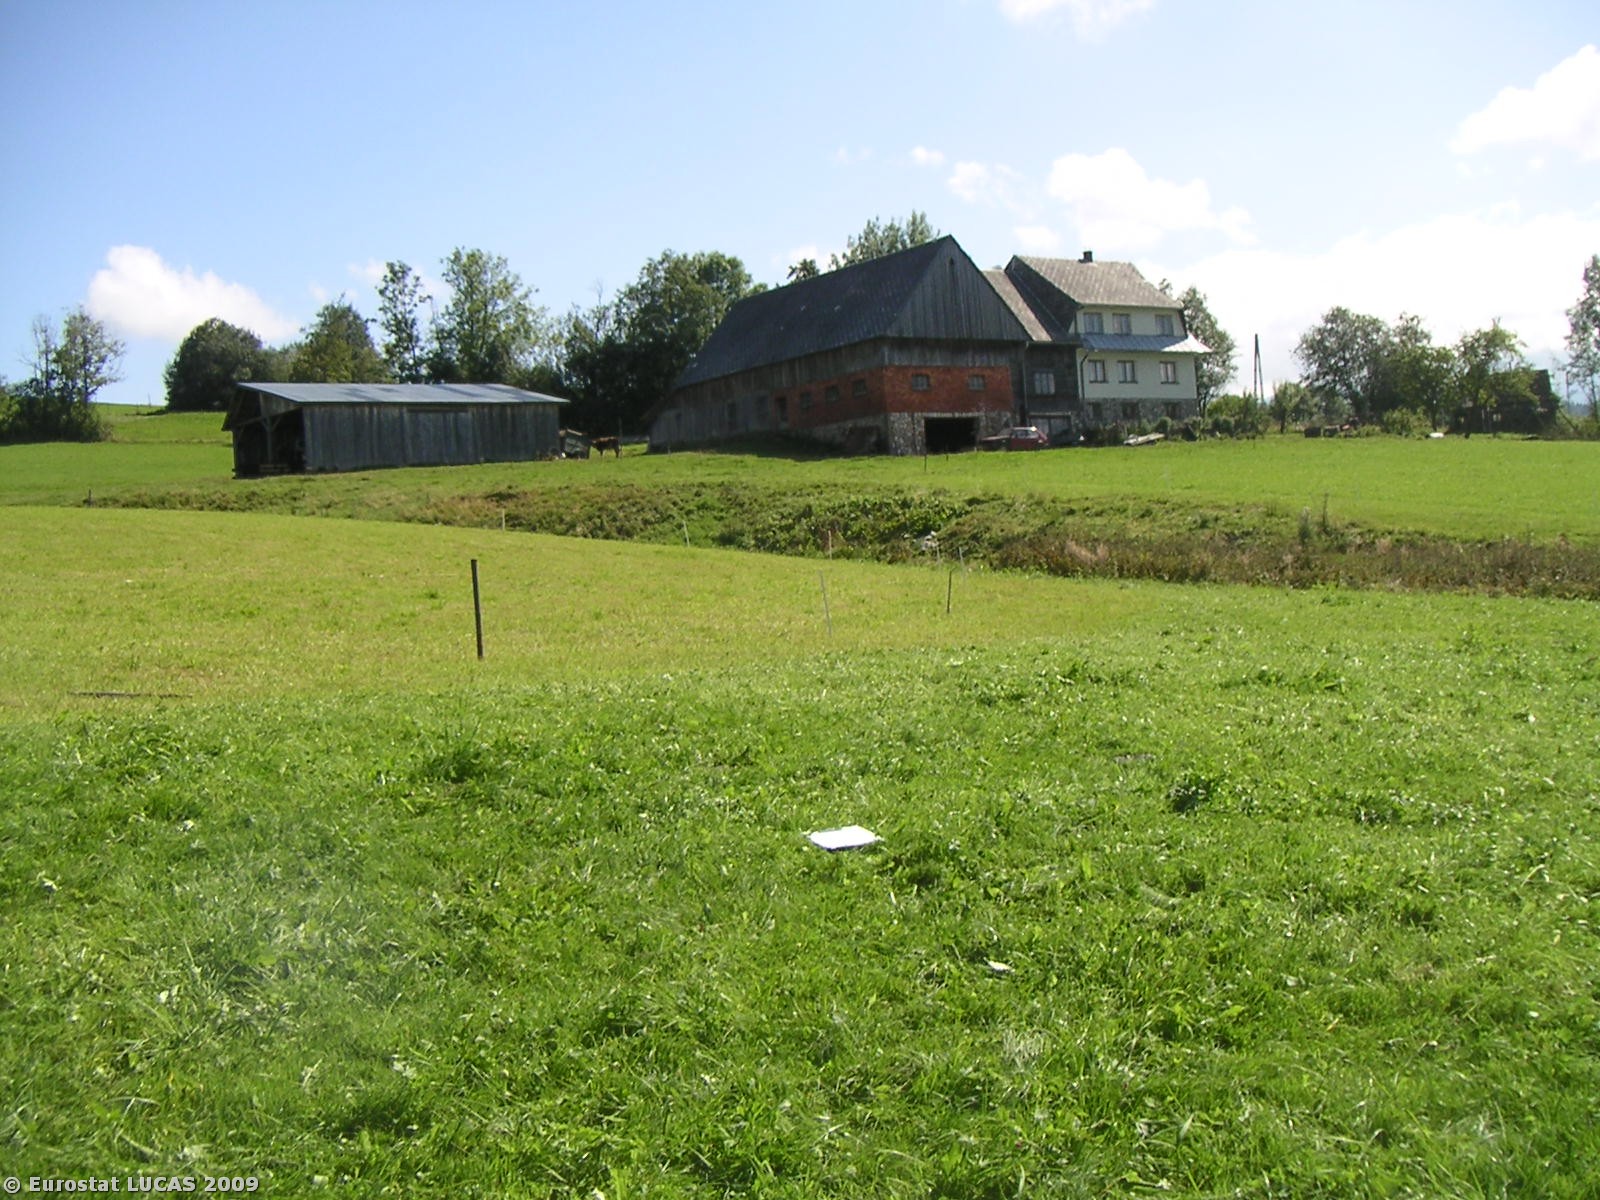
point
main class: Grassland
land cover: Grassland without tree/shrub cover
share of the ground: > 75 %
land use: Agriculture (excluding fallow land and kitchen gardens)
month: September
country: PL
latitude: 49.3406
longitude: 19.8429
